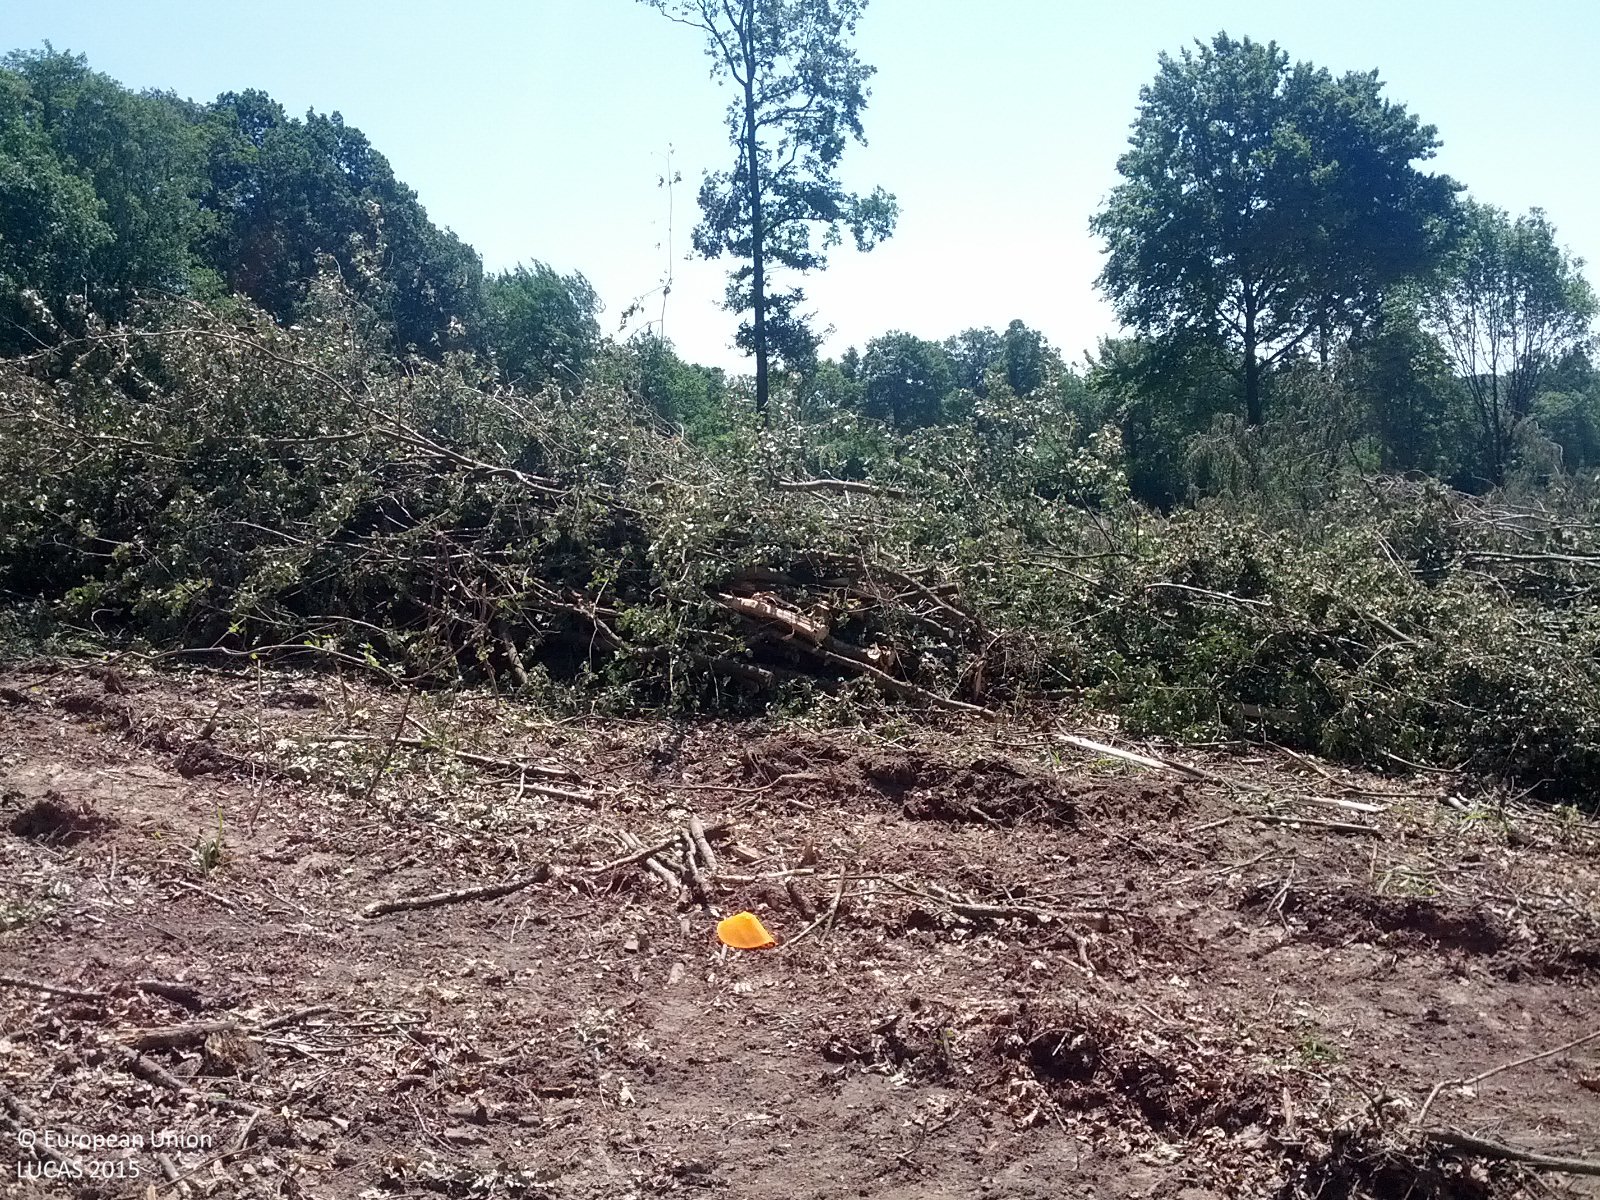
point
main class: Woodland
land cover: Broadleaved woodland
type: mesophytic deciduous forest
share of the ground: < 10 %
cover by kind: unconsolidated bare surface 90 %, broadleaved forest trees 10 %
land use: Forestry
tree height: > 5 m
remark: Clear cut
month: July
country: AT
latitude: 48.6239
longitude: 16.5592
